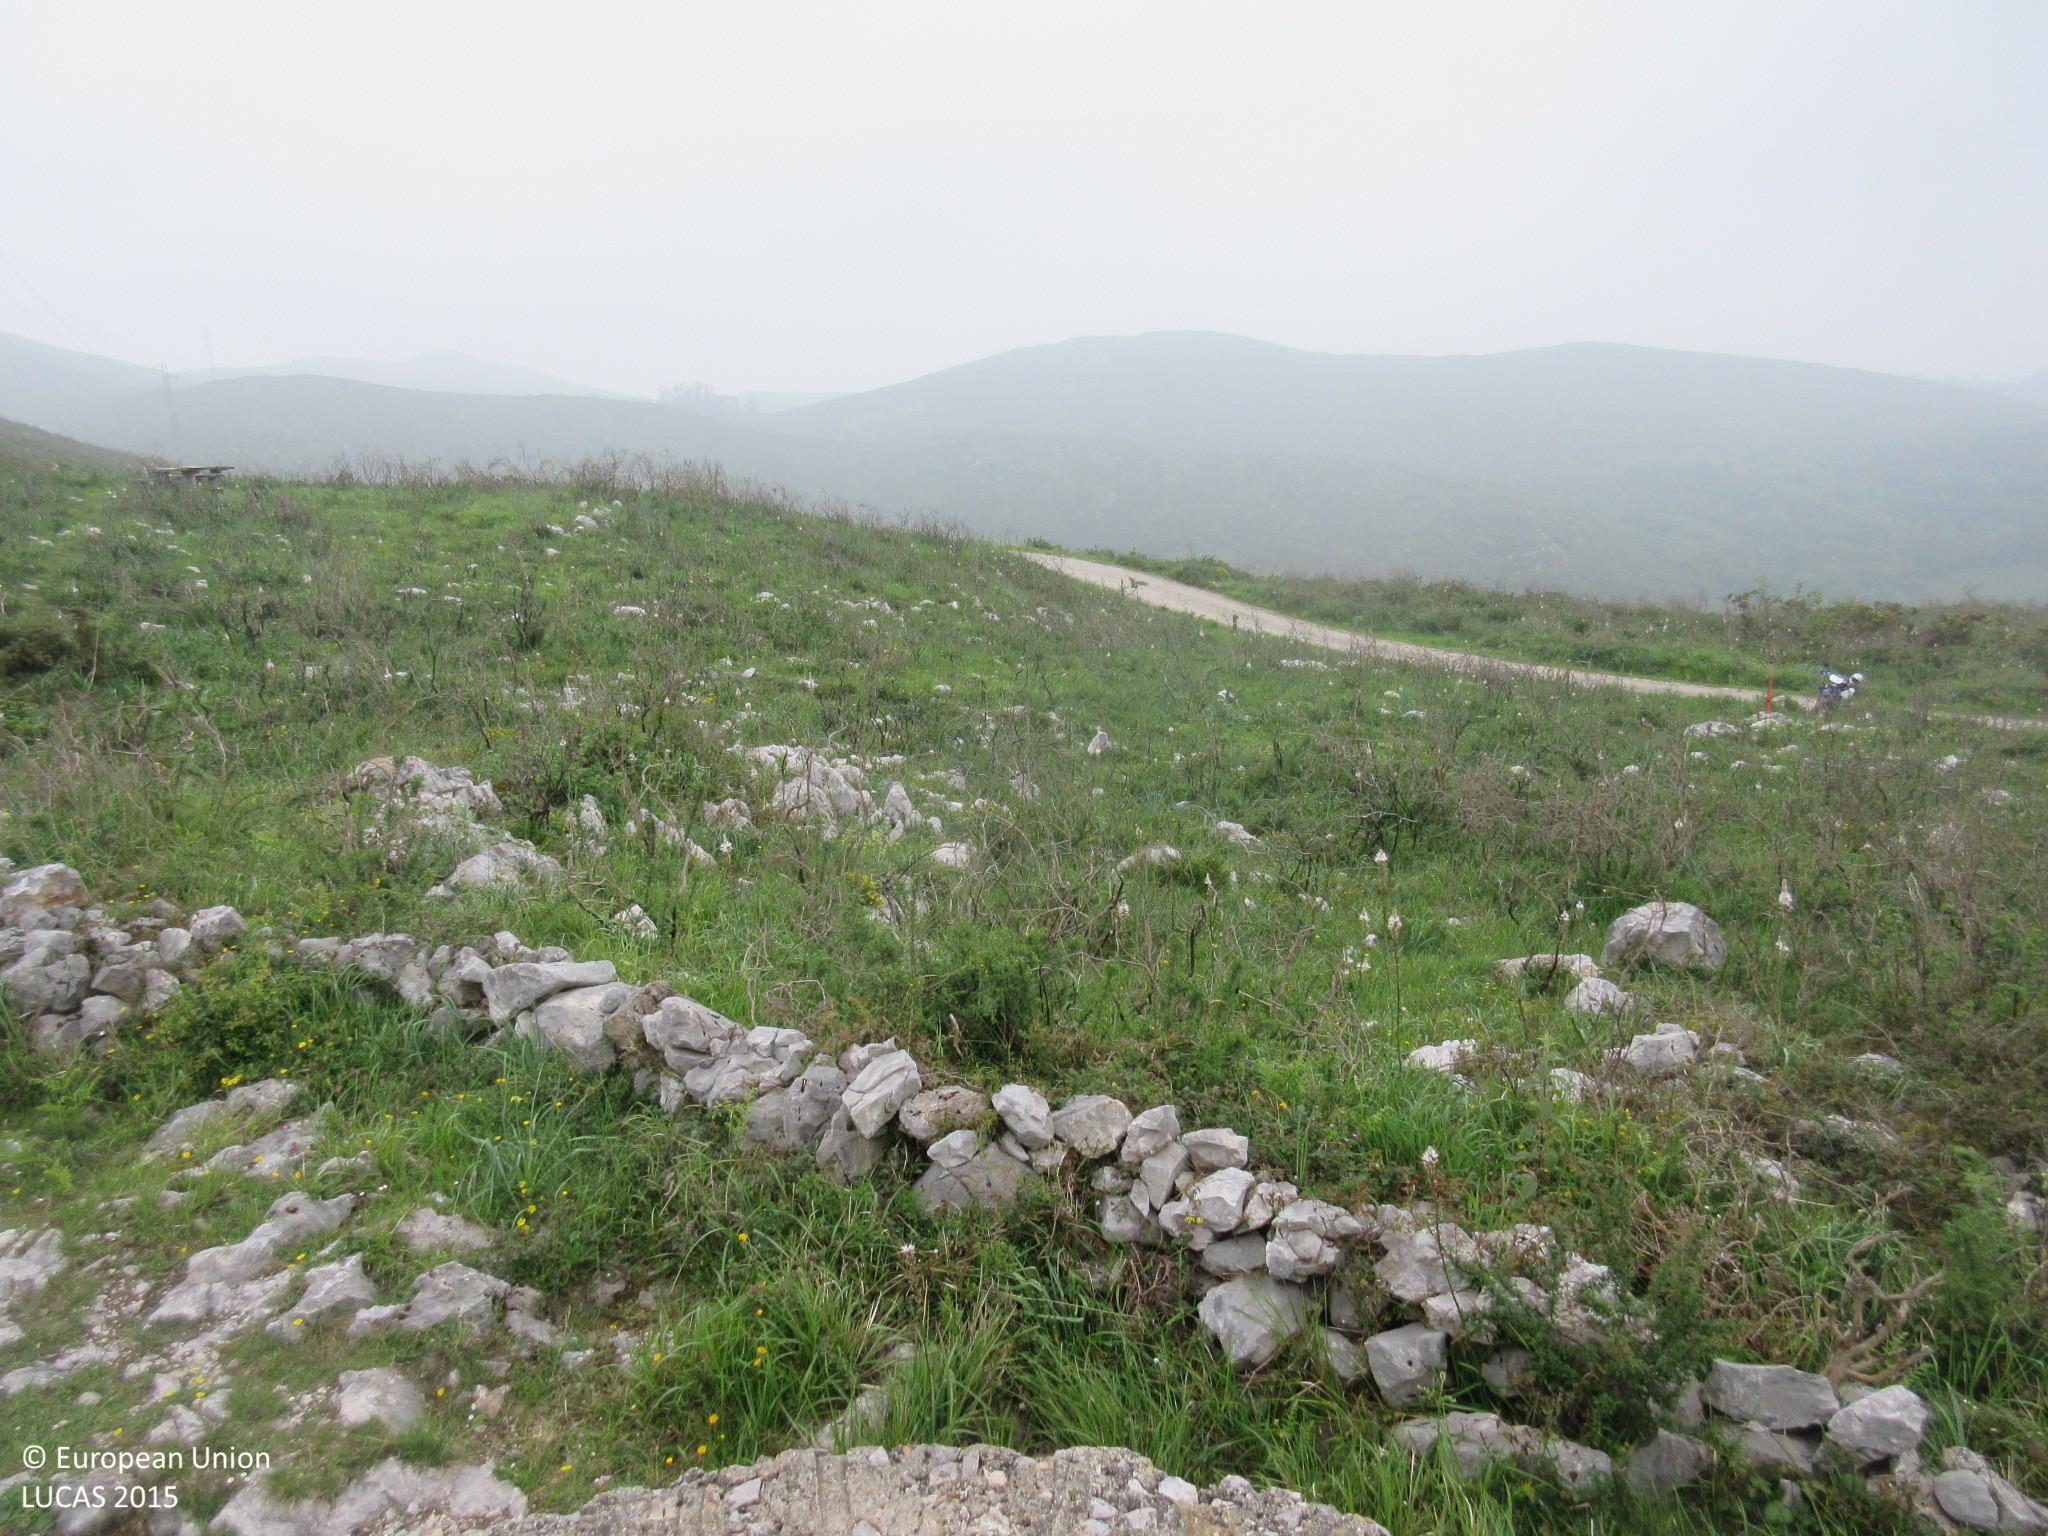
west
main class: Shrubland
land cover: Shrubland with sparse tree cover
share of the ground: > 75 %
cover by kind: shrubs 95 %, broadleaved forest trees 5 %
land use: Semi-natural and natural areas not in use
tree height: > 5 m
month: May
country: ES
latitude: 43.3938
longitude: -5.8791
